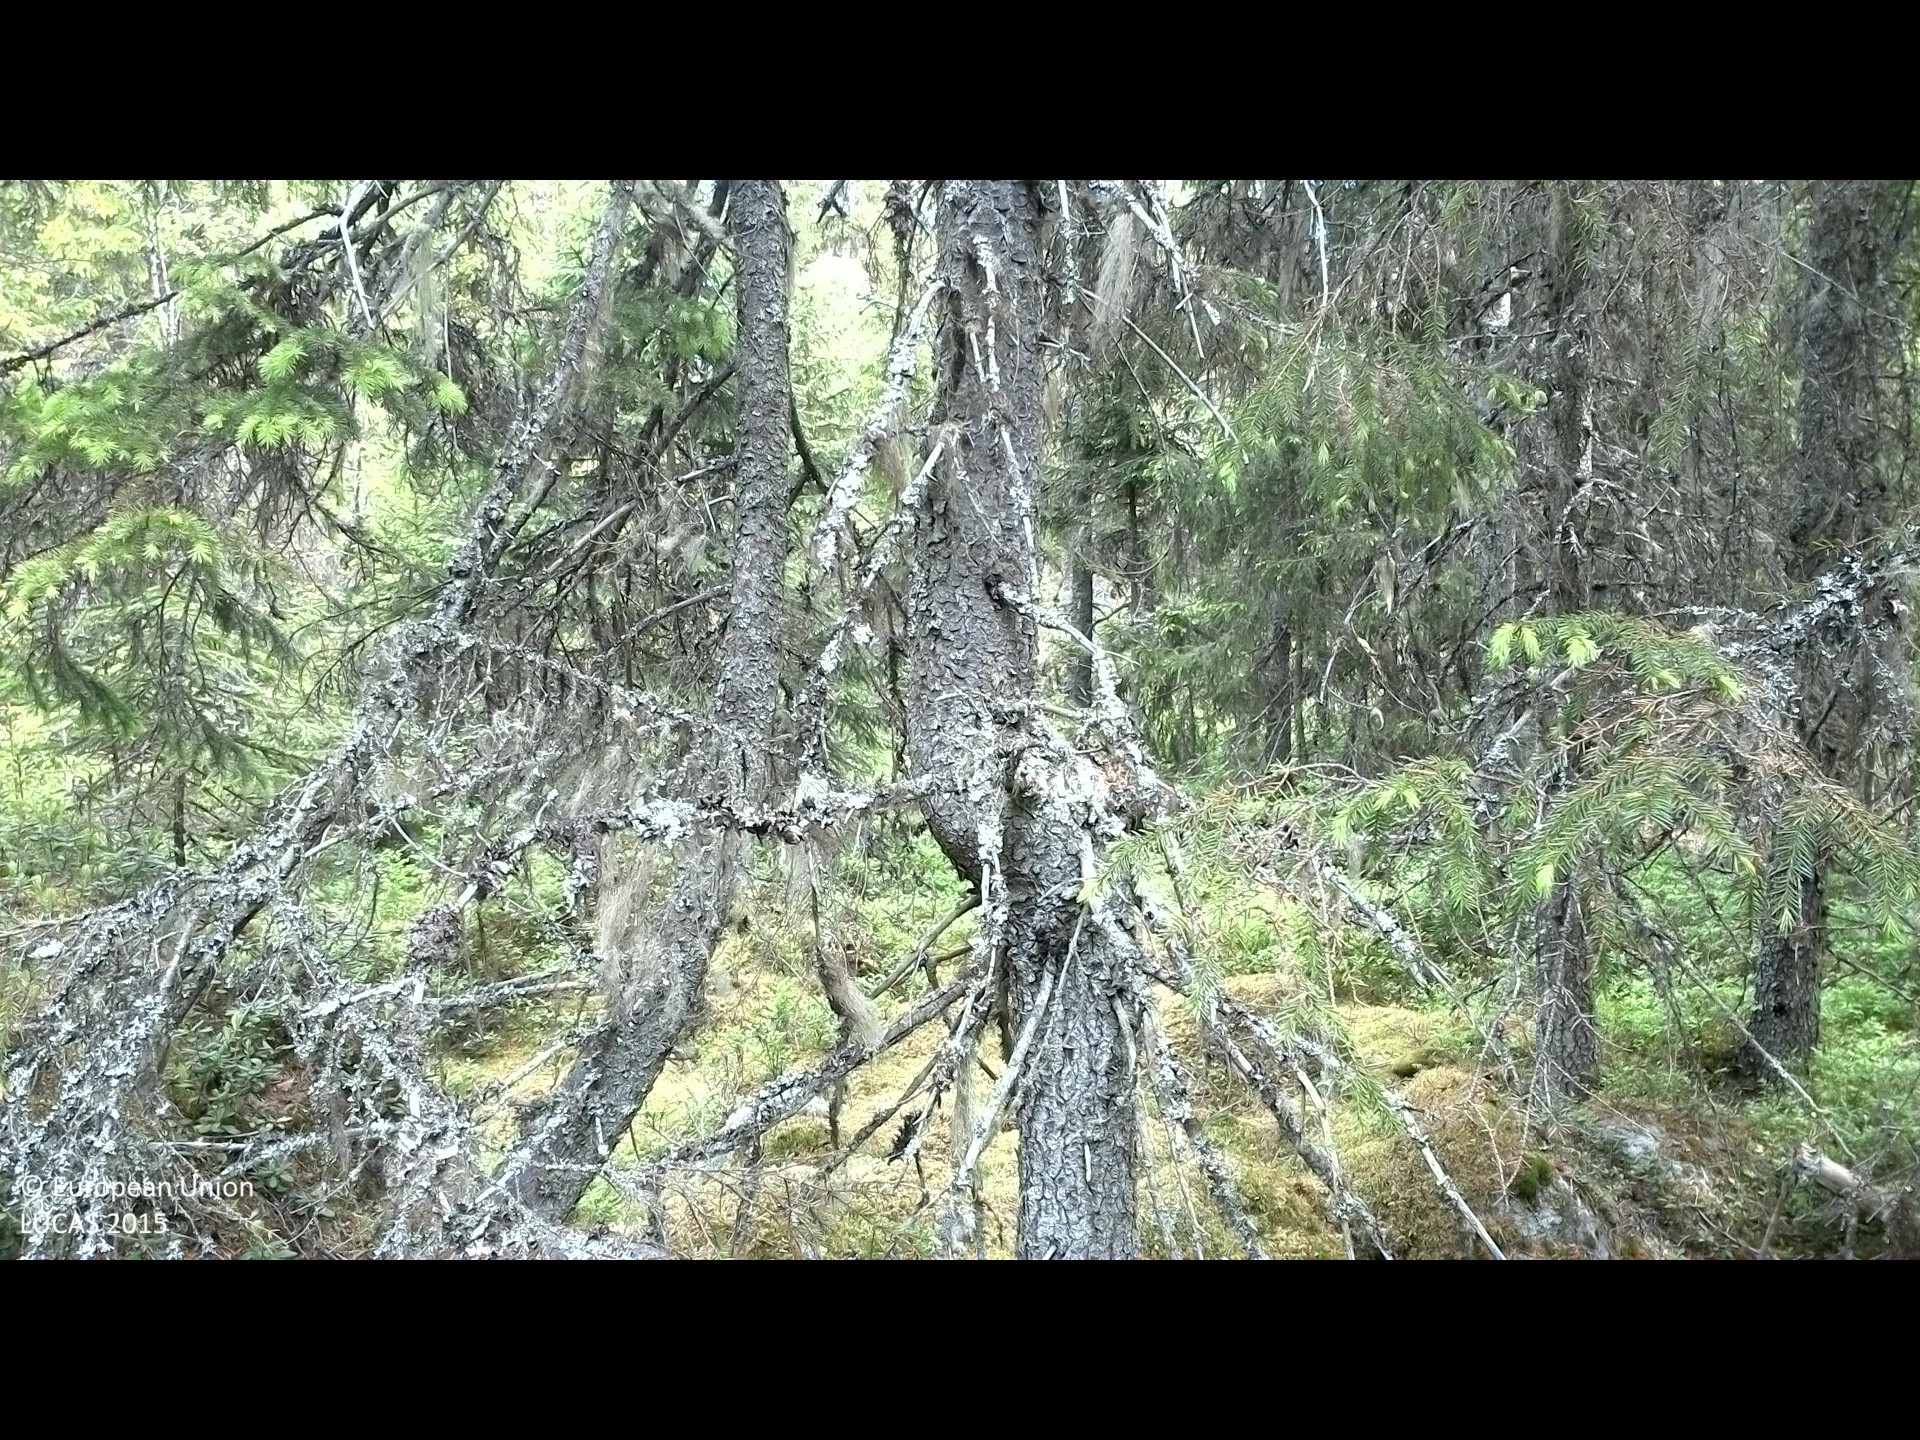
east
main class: Woodland
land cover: Spruce dominated coniferous woodland
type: boreal forest
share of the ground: 50 - 75 %
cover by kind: coniferous forest trees 60 %, lichens and mosses 20 %, shrubs 15 %, herbaceous plants 5 %
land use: Amenities, museums, leisure
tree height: > 5 m
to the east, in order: Spruce dominated coniferous woodland; Pine dominated coniferous woodland; Broadleaved woodland; Grassland with sparse tree/shrub cover
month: June
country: SE
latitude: 62.2201
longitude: 17.6174
